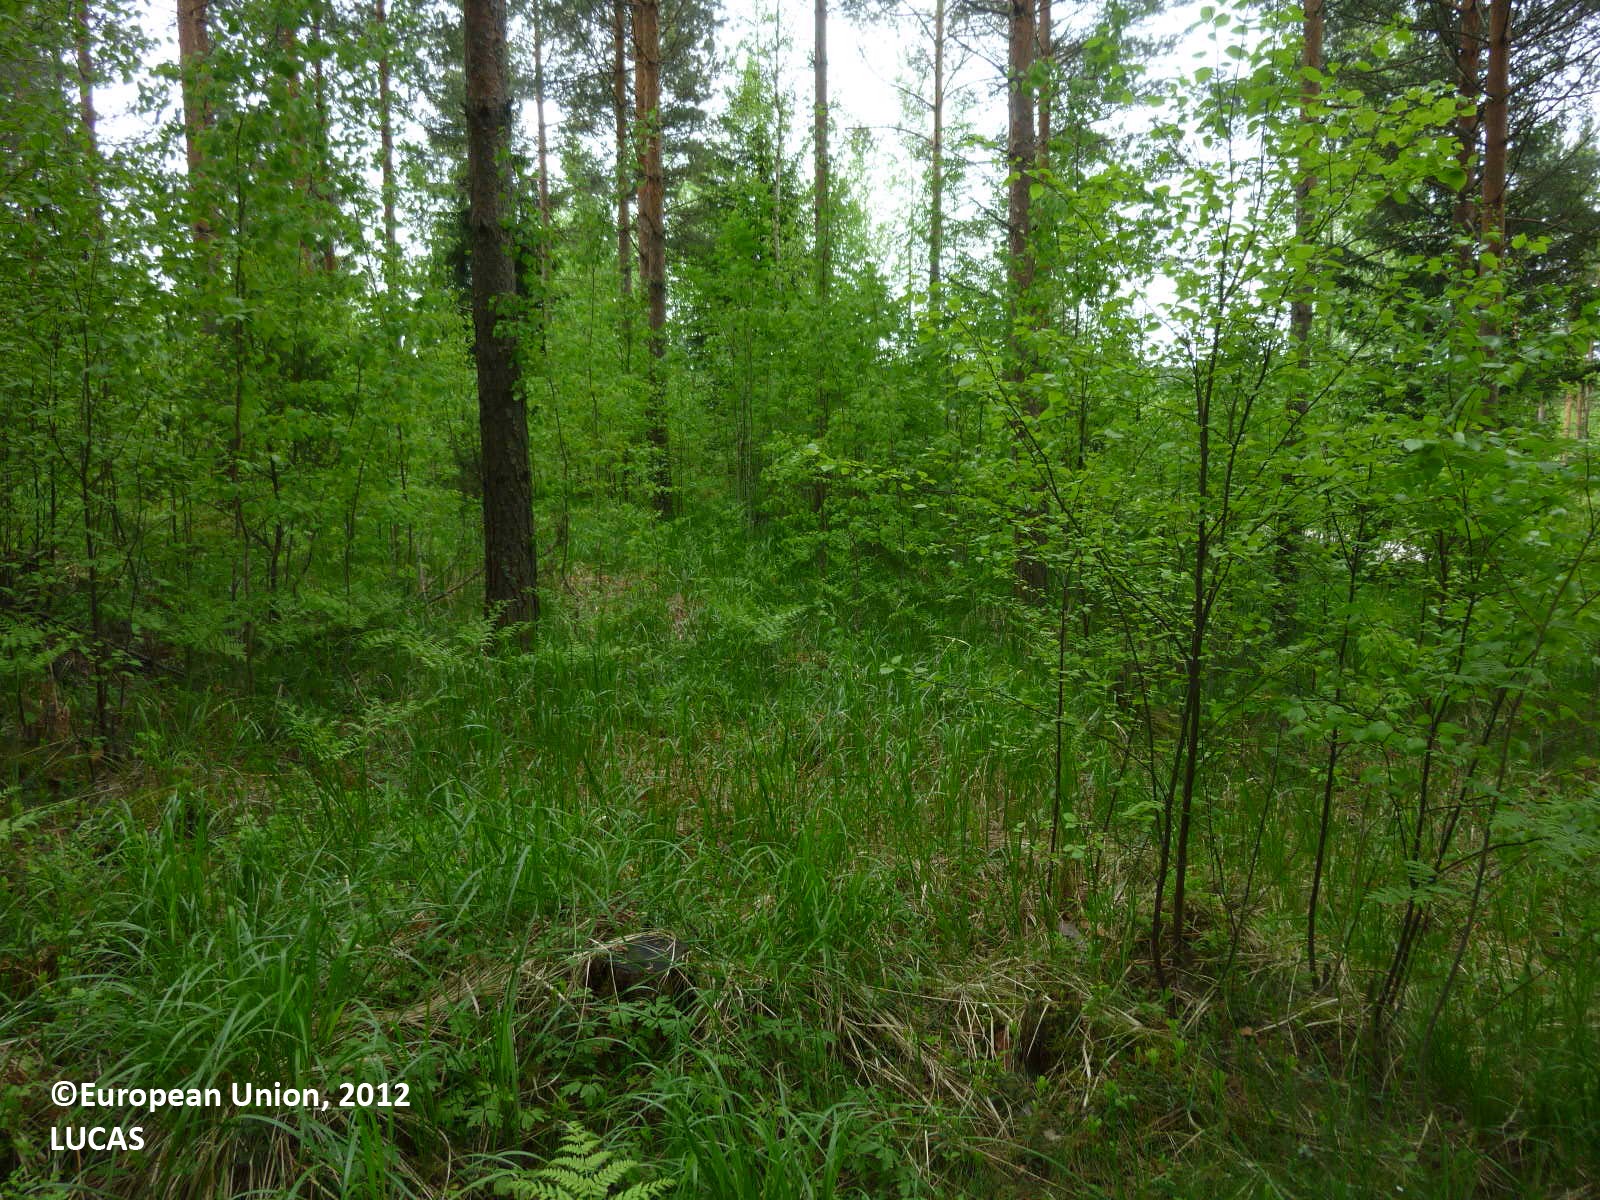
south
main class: Woodland
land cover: Pine dominated coniferous woodland
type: boreal forest
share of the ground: 50 - 75 %
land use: Forestry
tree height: > 5 m
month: June
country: FI
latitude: 60.4260
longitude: 22.6978
